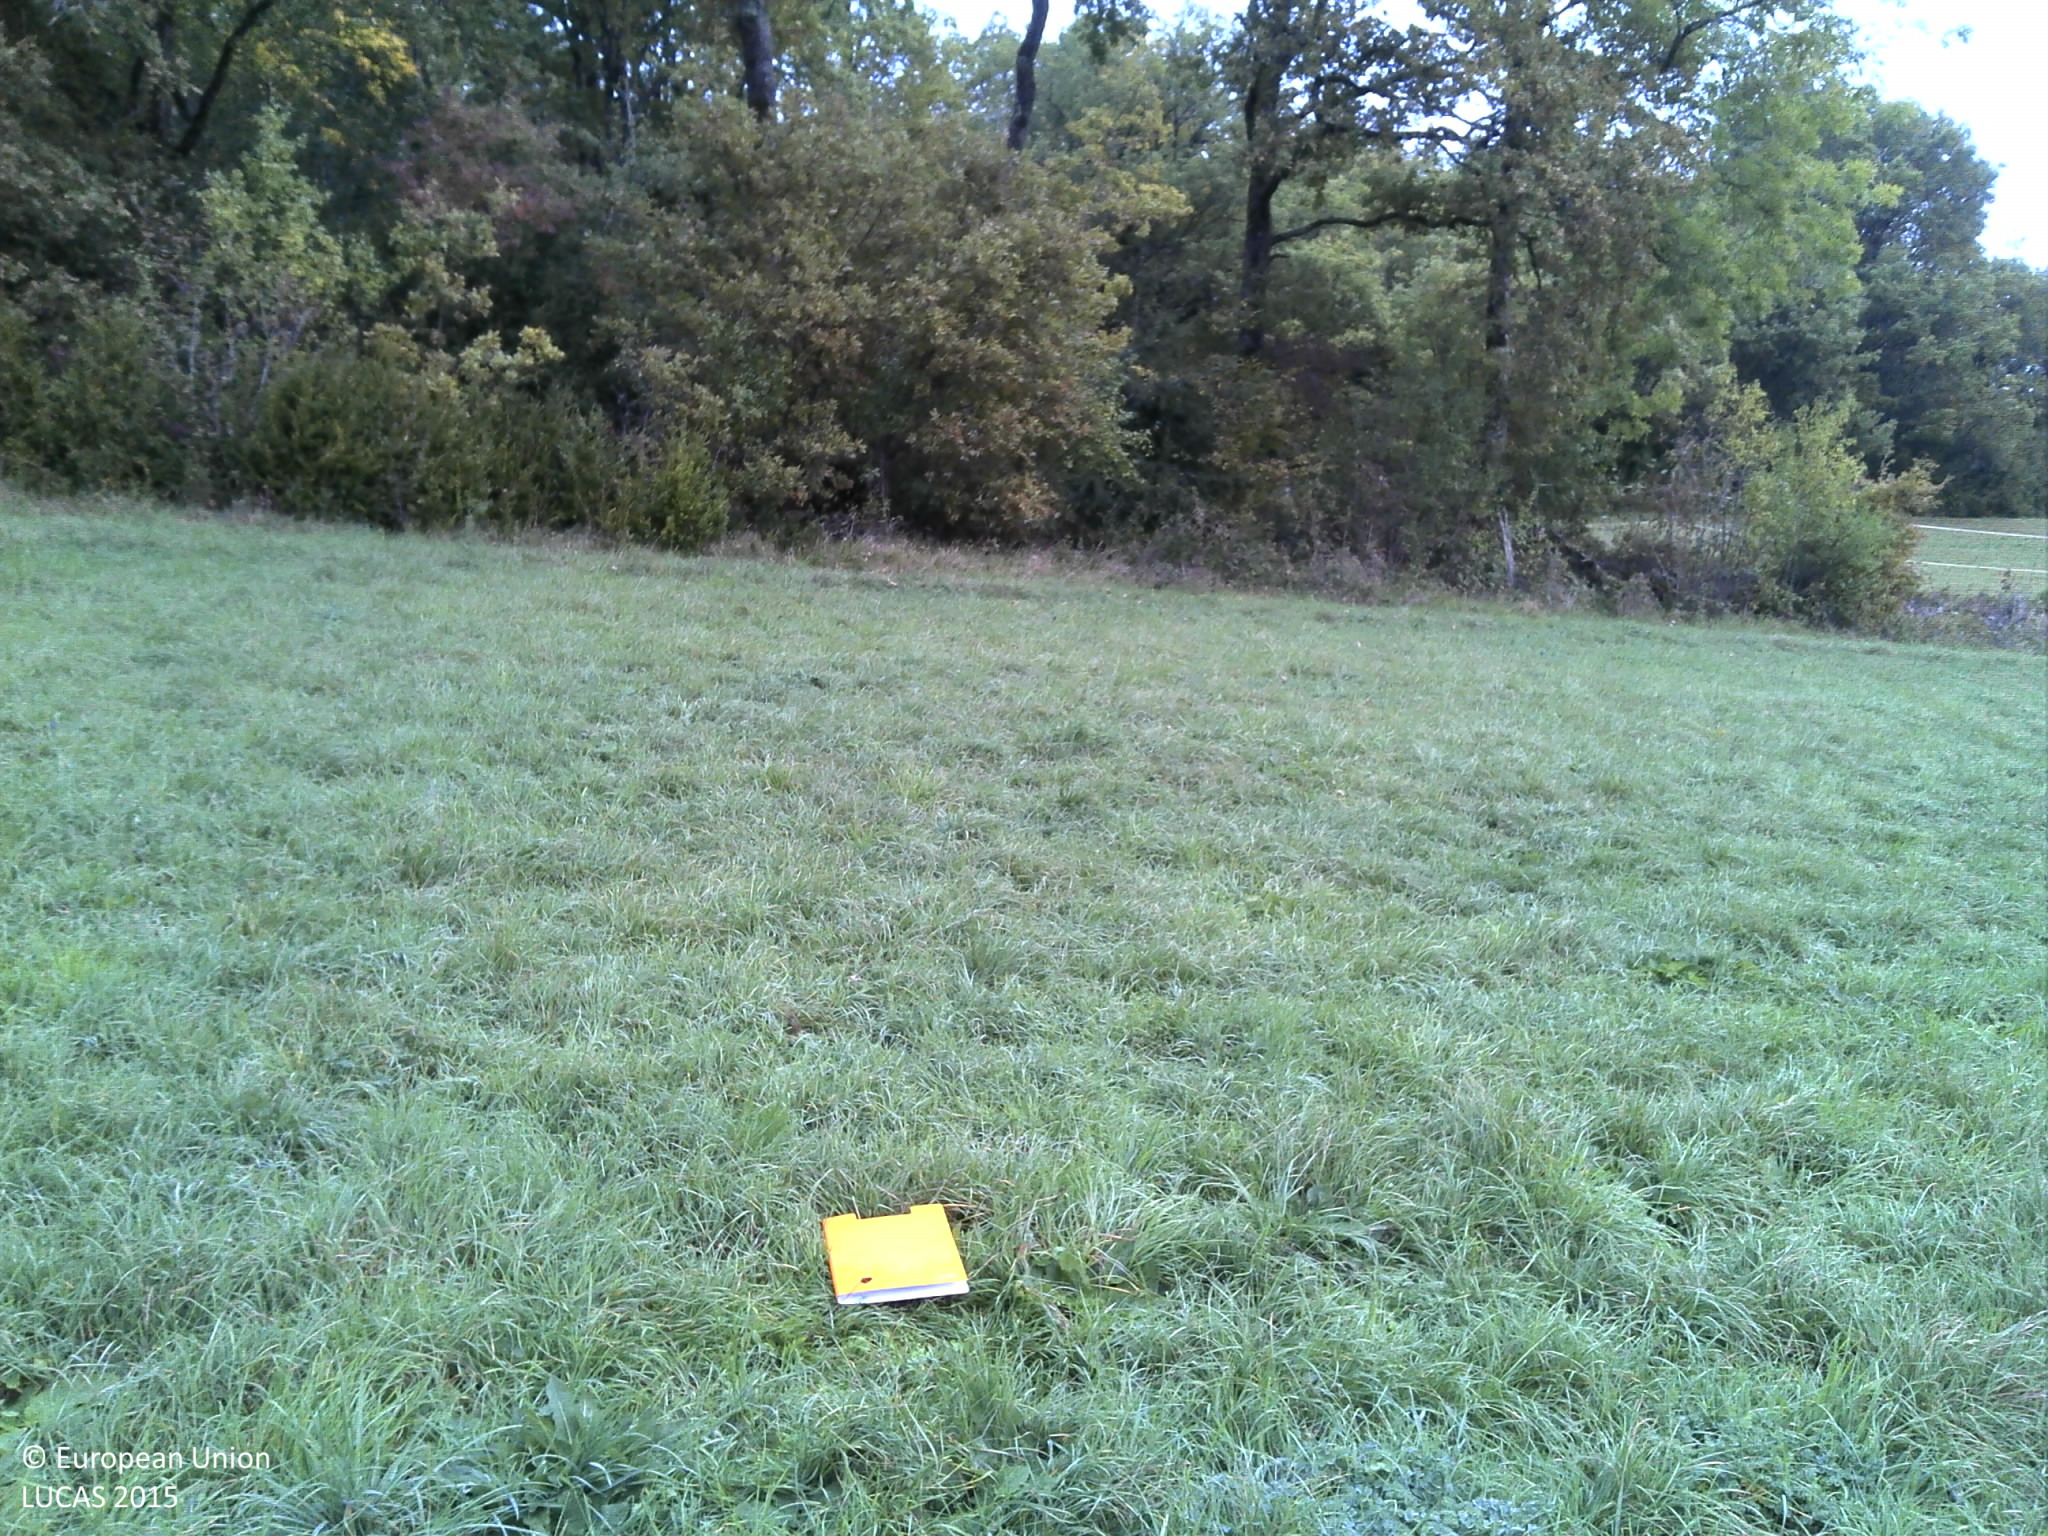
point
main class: Grassland
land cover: Grassland without tree/shrub cover
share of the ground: > 75 %
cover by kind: herbaceous plants 100 %
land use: Agriculture (excluding fallow land and kitchen gardens)
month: October
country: FR
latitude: 46.1242
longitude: 5.3573
